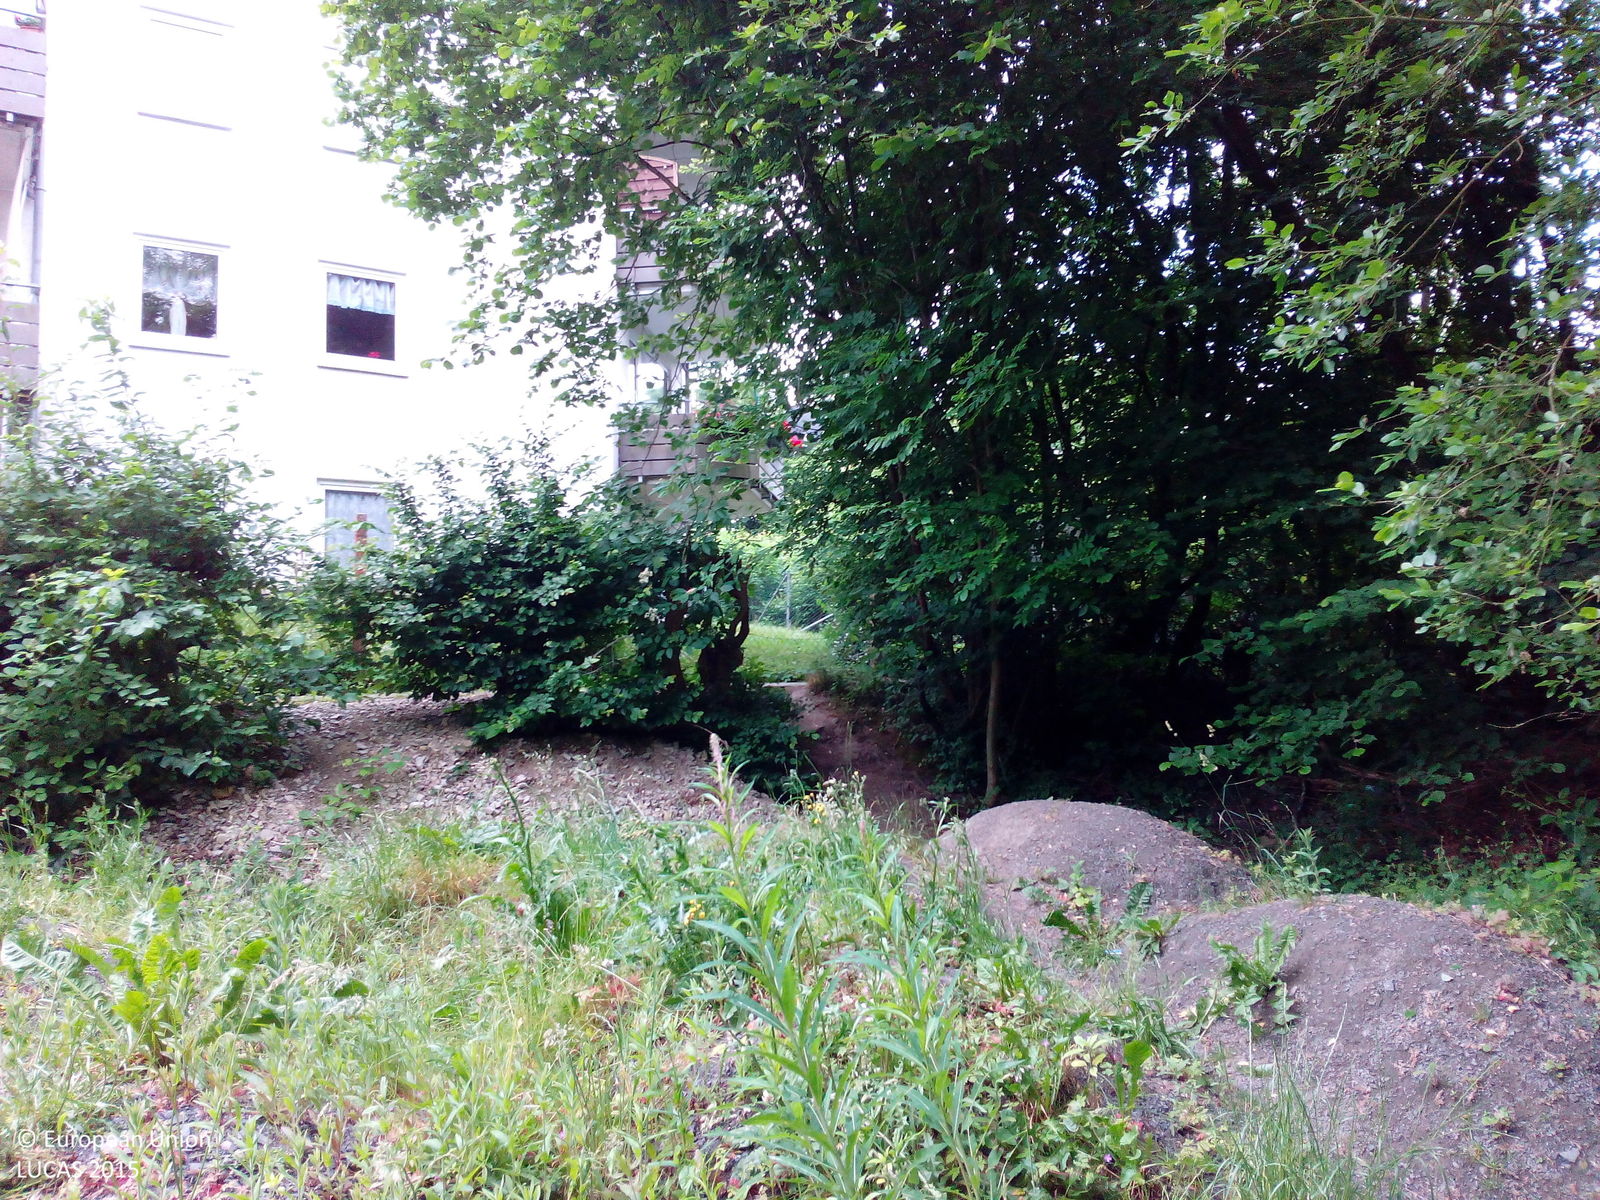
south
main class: Woodland
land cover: Broadleaved woodland
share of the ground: 50 - 75 %
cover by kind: broadleaved forest trees 70 %, herbaceous plants 30 %
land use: Residential
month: June
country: DE
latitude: 51.6579
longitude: 9.6387
